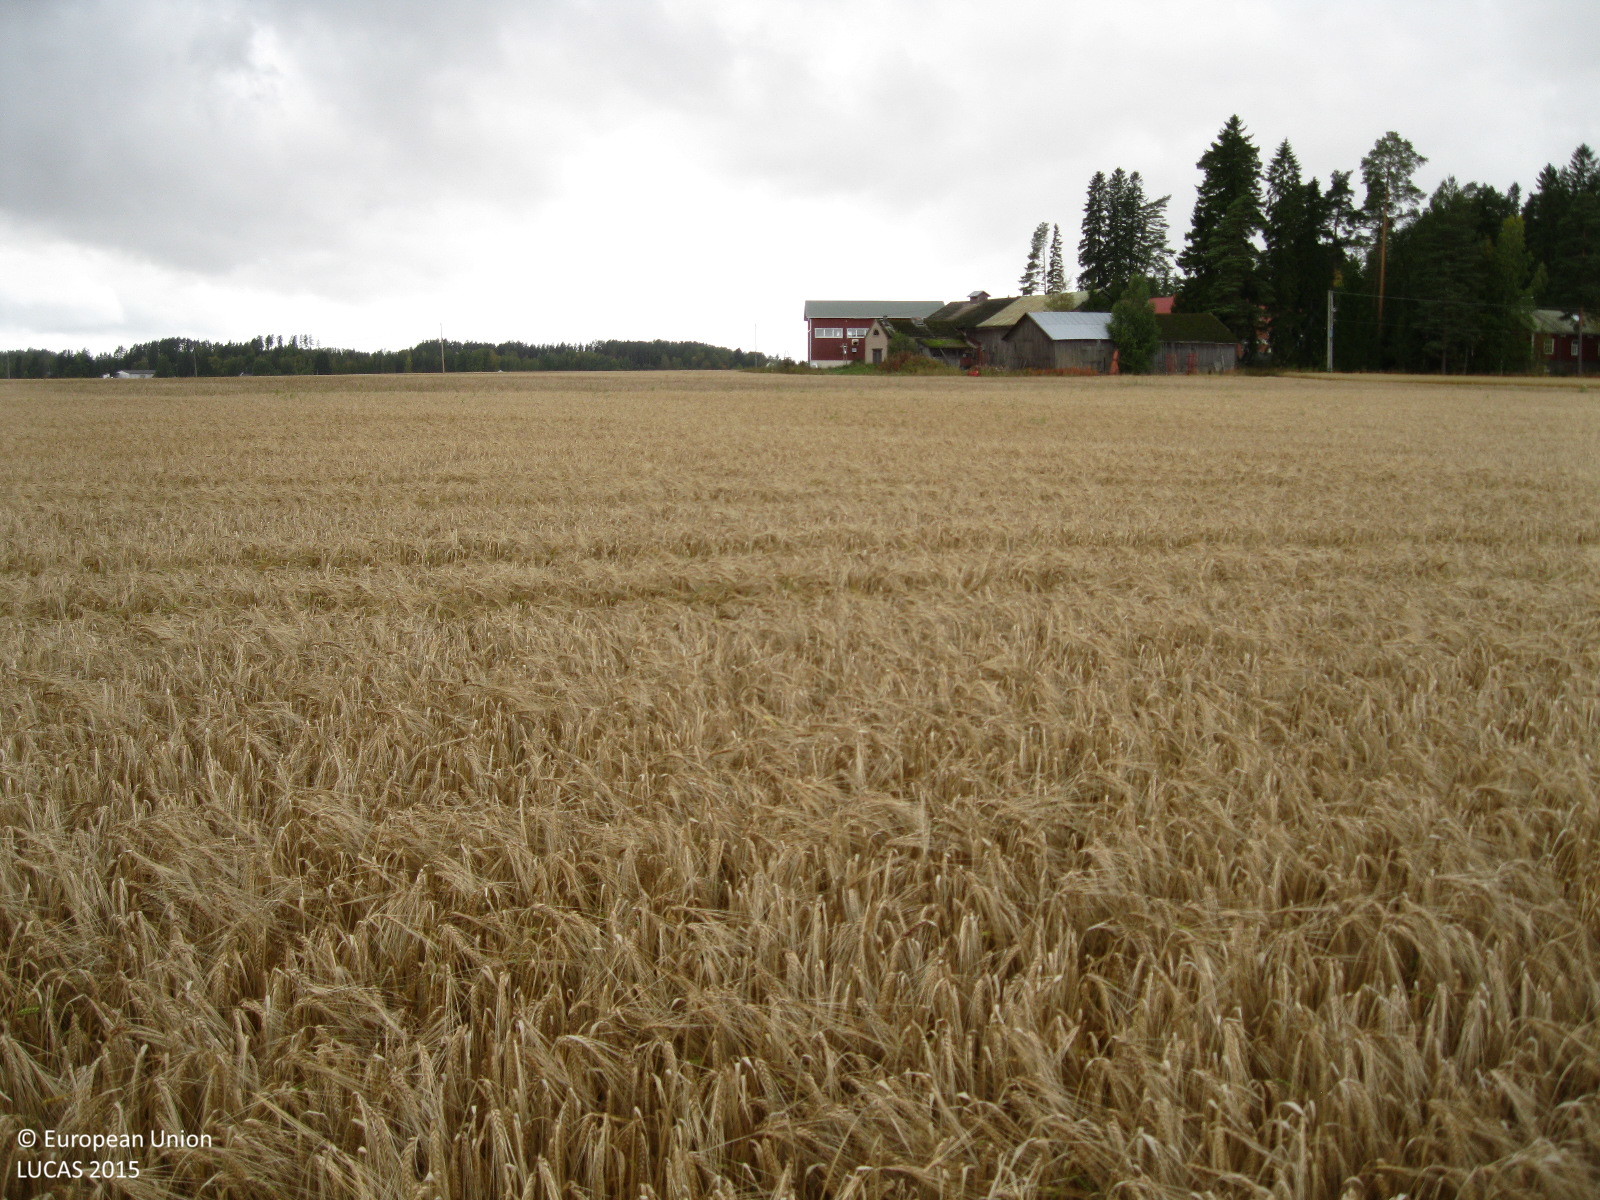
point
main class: Cropland
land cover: Barley
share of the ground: > 75 %
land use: Agriculture (excluding fallow land and kitchen gardens)
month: September
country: FI
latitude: 60.8224
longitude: 24.8404
